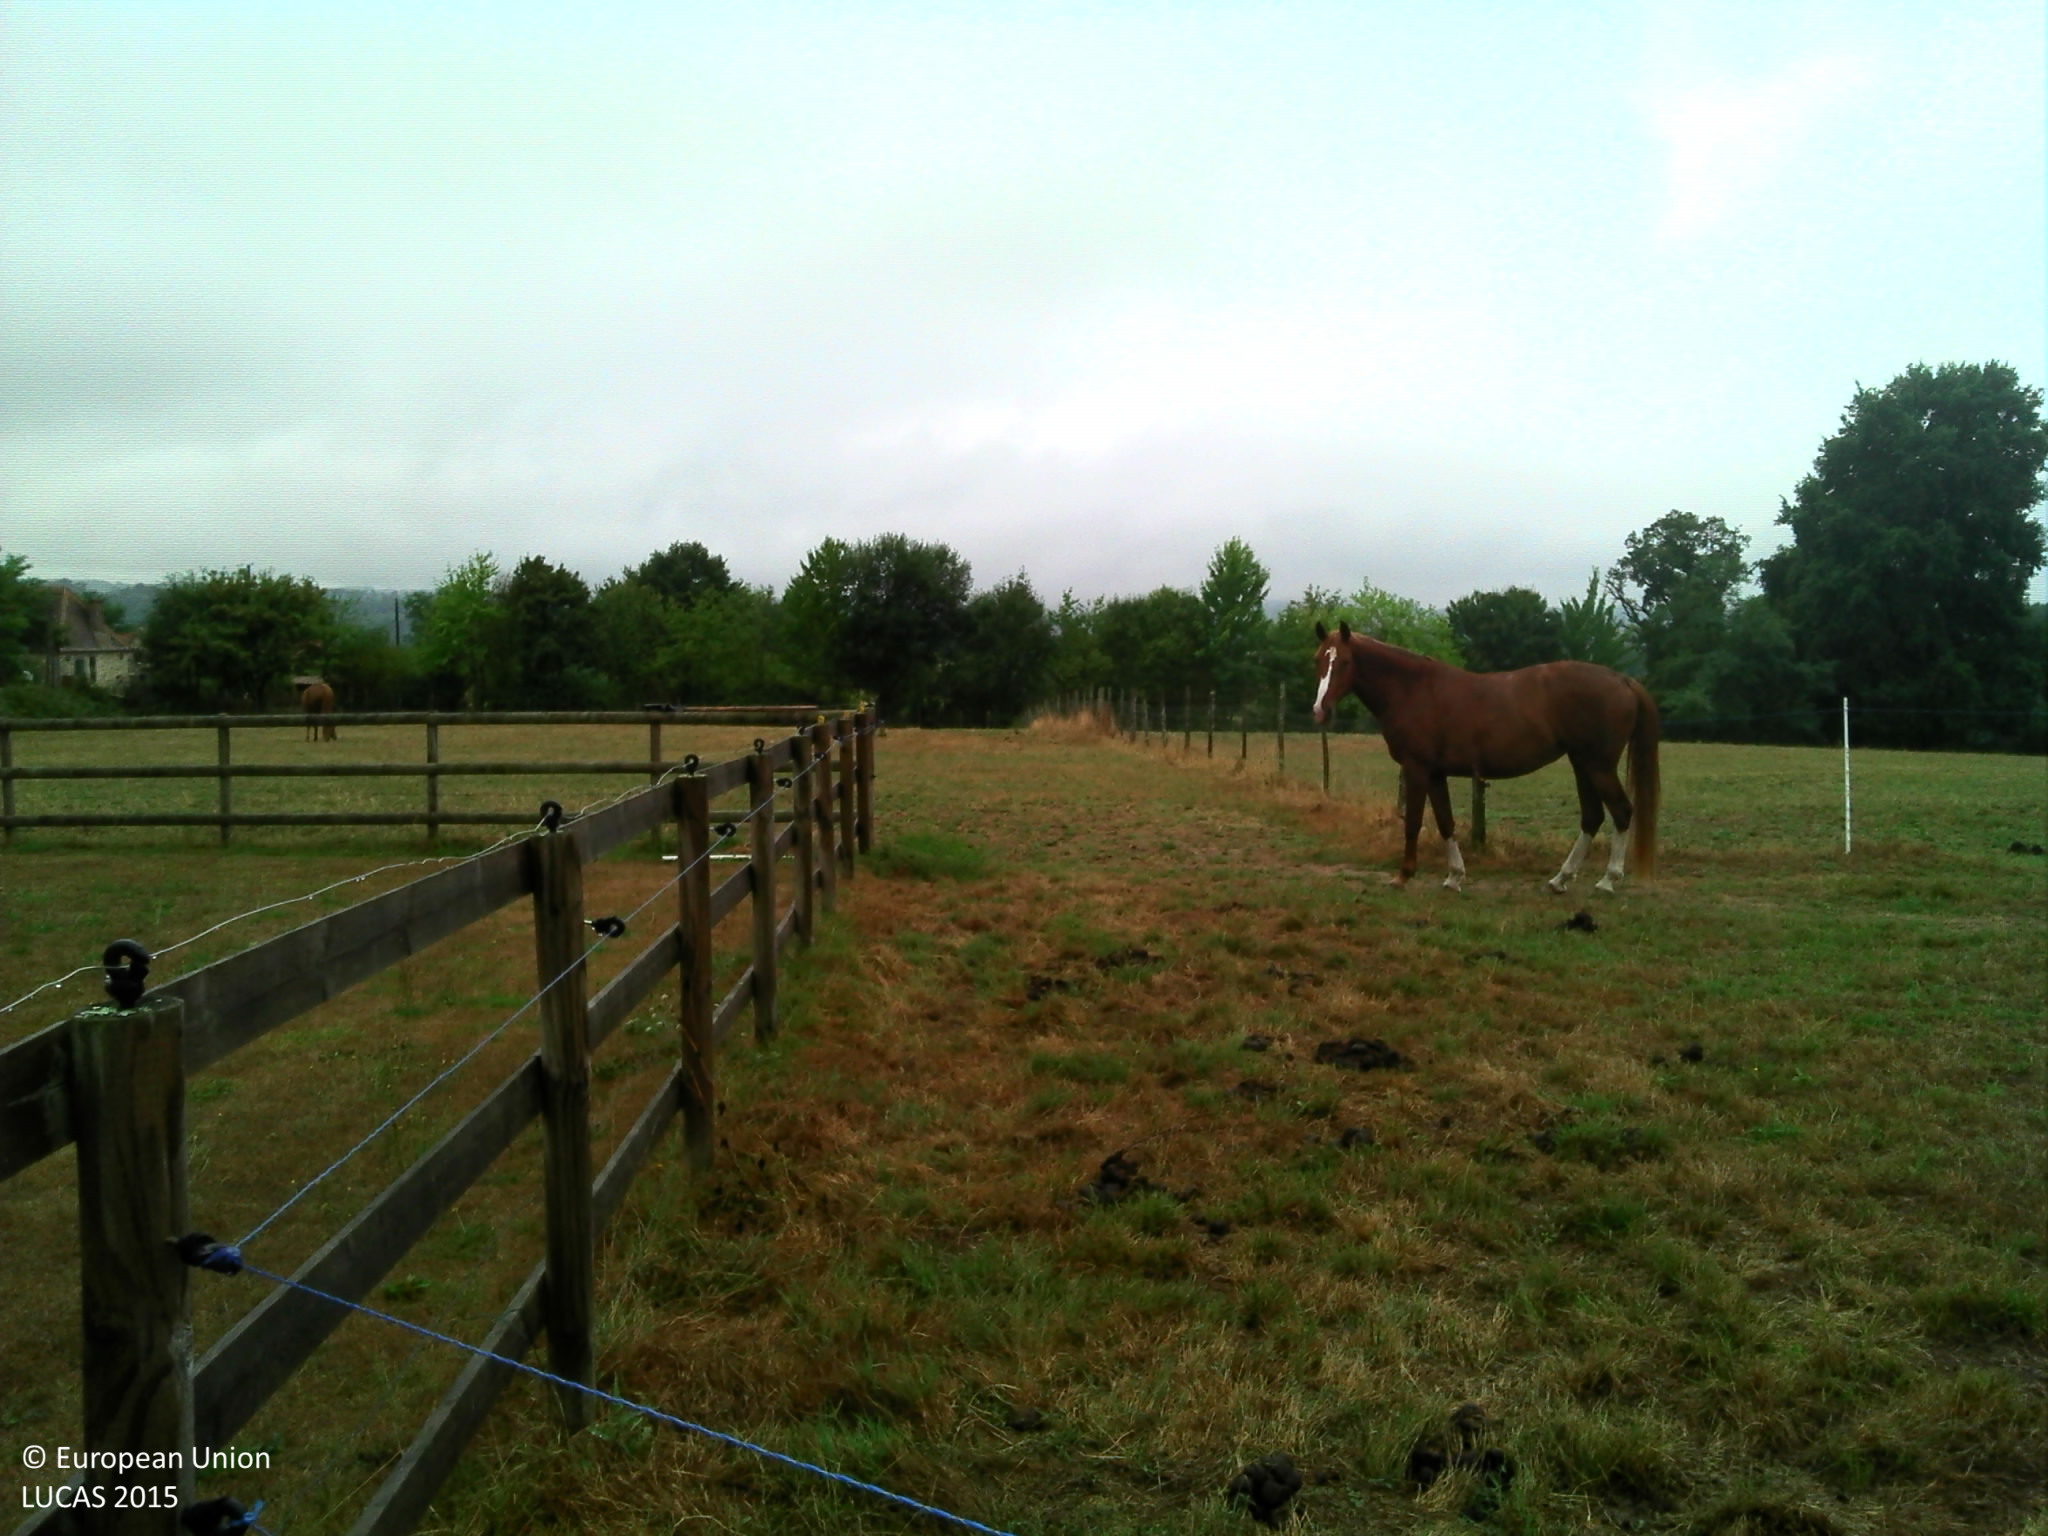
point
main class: Grassland
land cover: Grassland without tree/shrub cover
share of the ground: > 75 %
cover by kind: herbaceous plants 85 %, lichens and mosses 10 %, unconsolidated bare surface 5 %
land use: Agriculture (excluding fallow land and kitchen gardens)
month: August
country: FR
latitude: 45.4838
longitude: 1.0222
